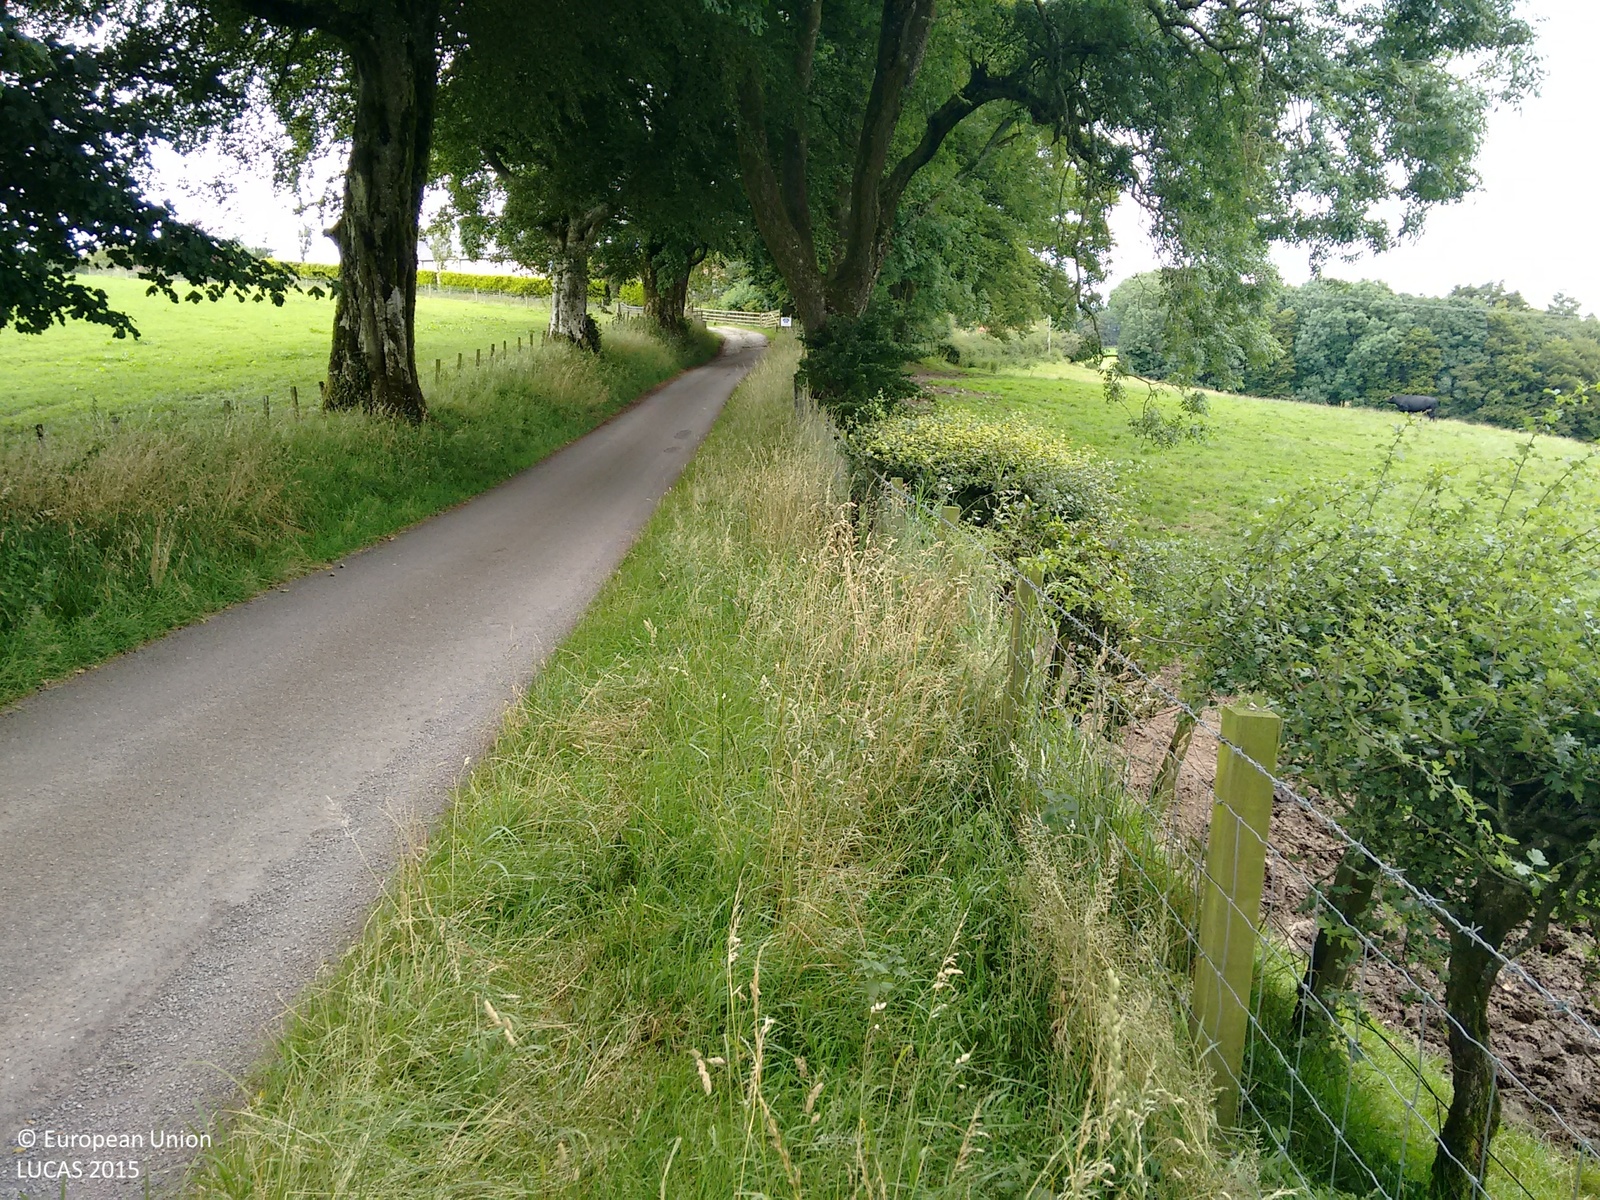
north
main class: Grassland
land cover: Grassland without tree/shrub cover
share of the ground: > 75 %
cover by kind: herbaceous plants 100 %
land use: Agriculture (excluding fallow land and kitchen gardens)
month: August
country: GB
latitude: 55.1939
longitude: -3.3512
